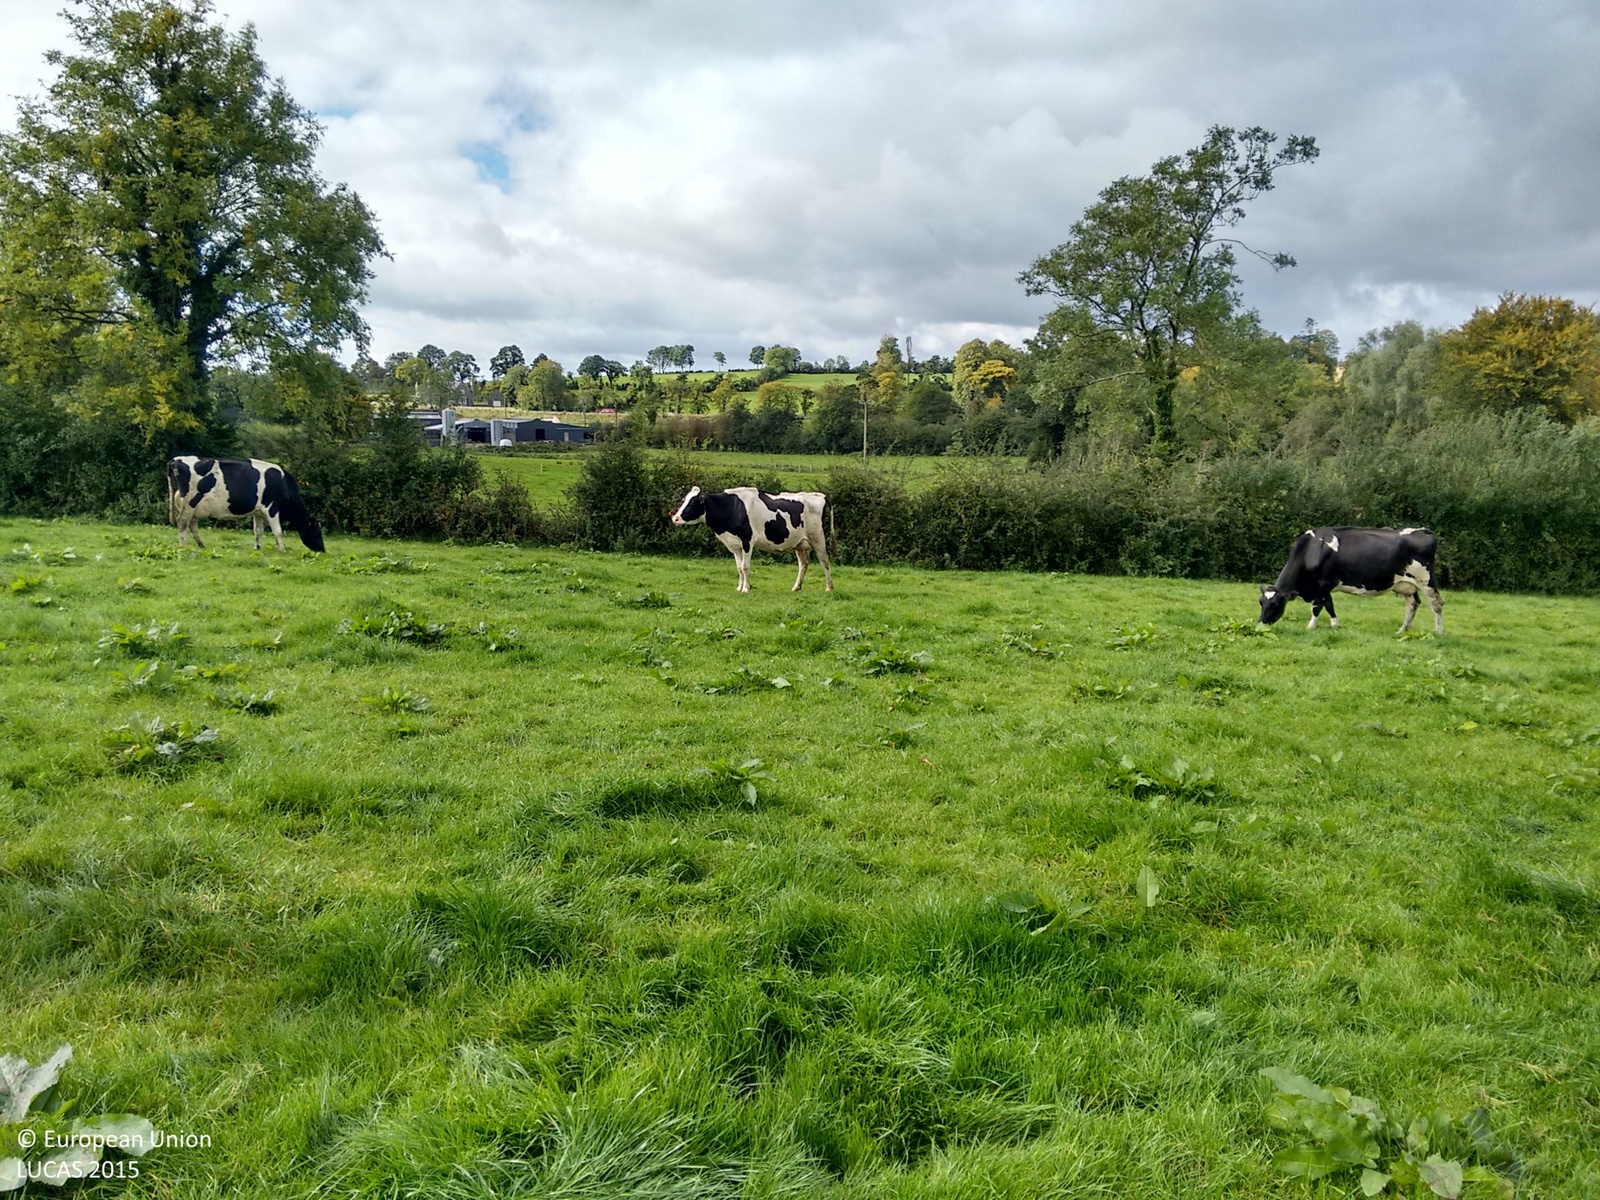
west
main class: Grassland
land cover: Grassland without tree/shrub cover
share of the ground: > 75 %
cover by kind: herbaceous plants 100 %
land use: Agriculture (excluding fallow land and kitchen gardens)
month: September
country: IE
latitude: 54.2906
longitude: -6.9613
